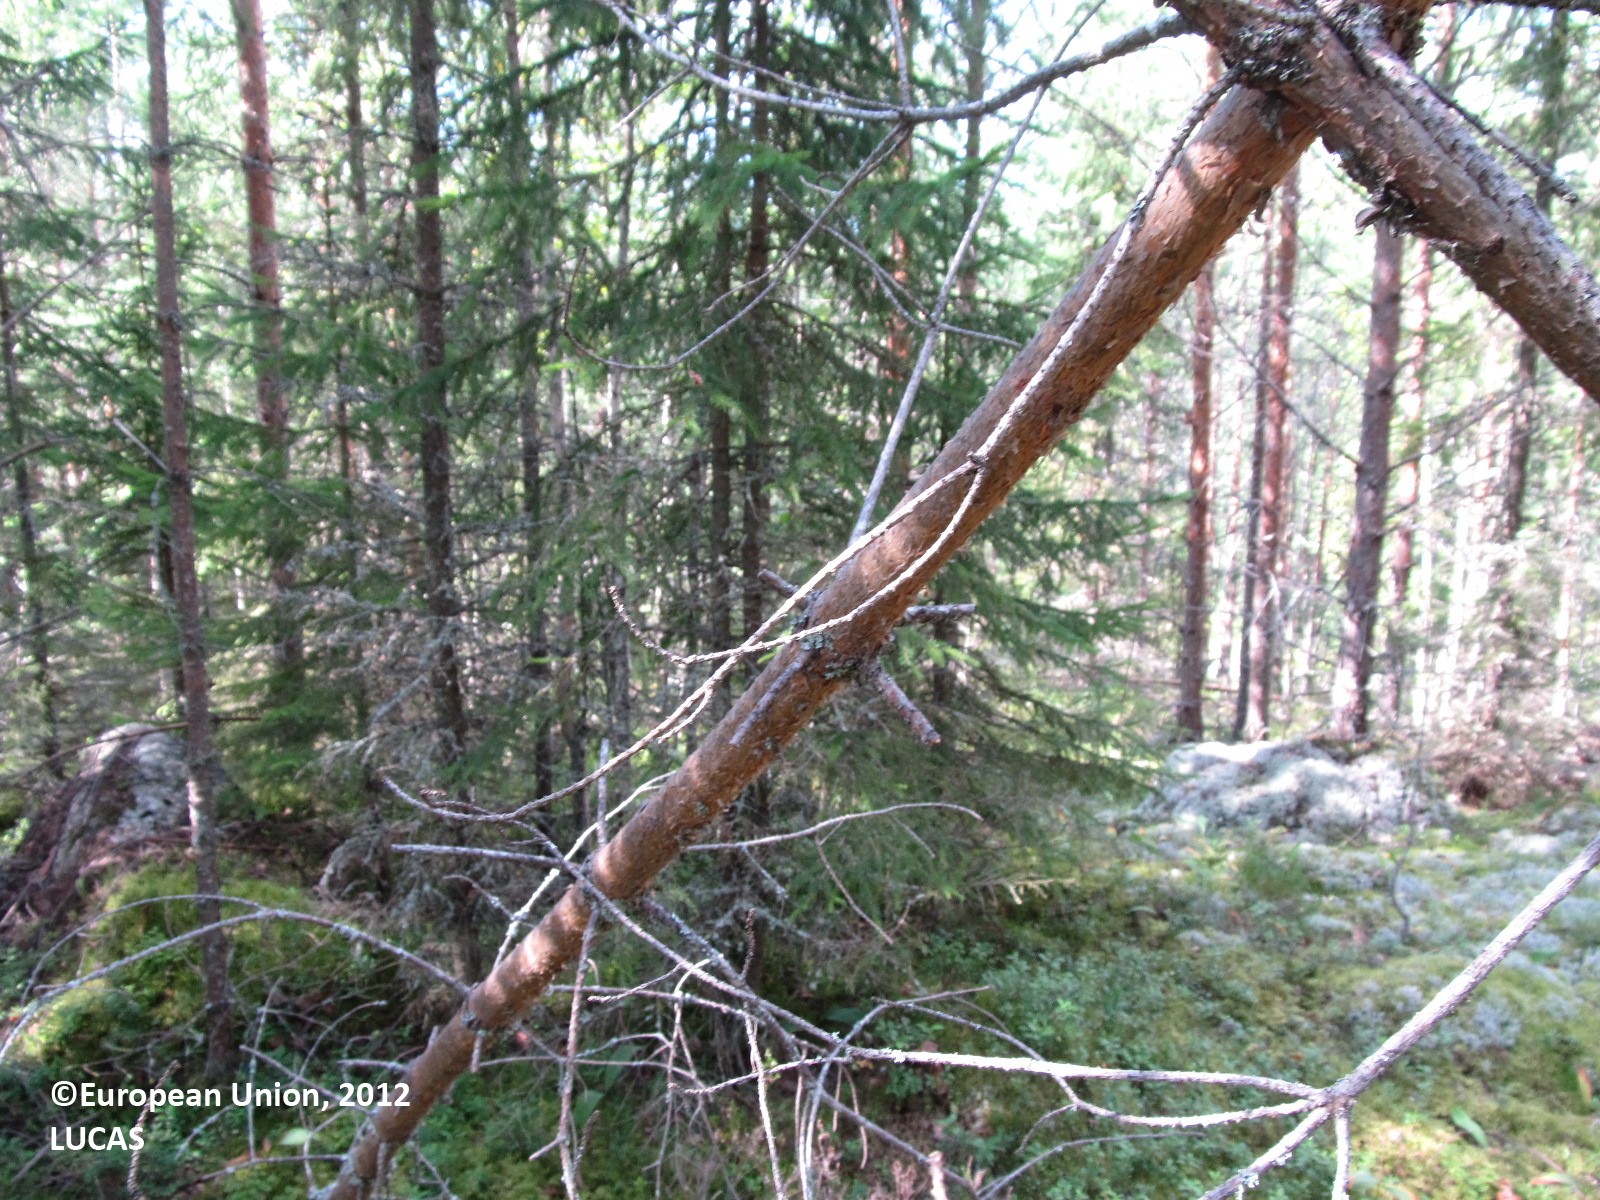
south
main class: Woodland
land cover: Other coniferous woodland
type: boreal forest
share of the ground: 50 - 75 %
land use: Forestry
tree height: > 5 m
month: August
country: FI
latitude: 62.3929
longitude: 27.6399
